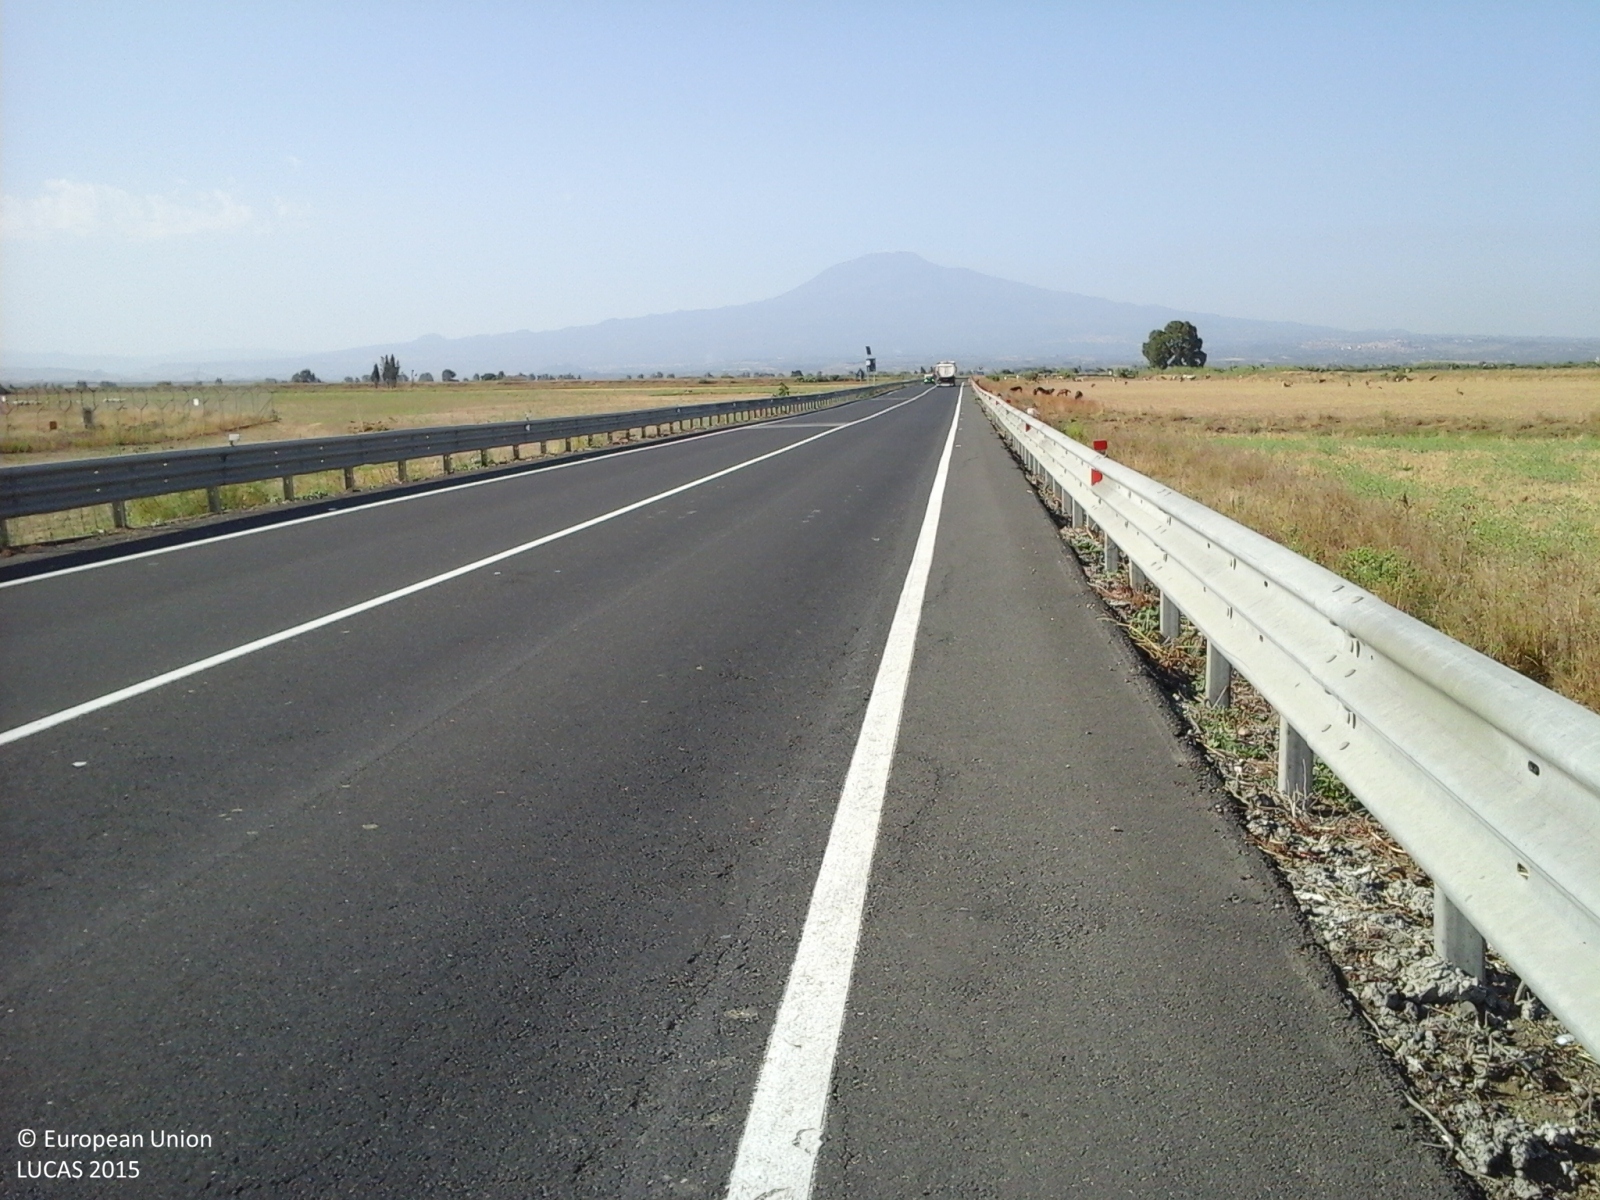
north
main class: Grassland
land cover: Spontaneously vegetated surfaces
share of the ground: > 75 %
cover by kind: herbaceous plants 100 %
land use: Community services
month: June
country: IT
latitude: 37.4041
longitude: 14.8784
